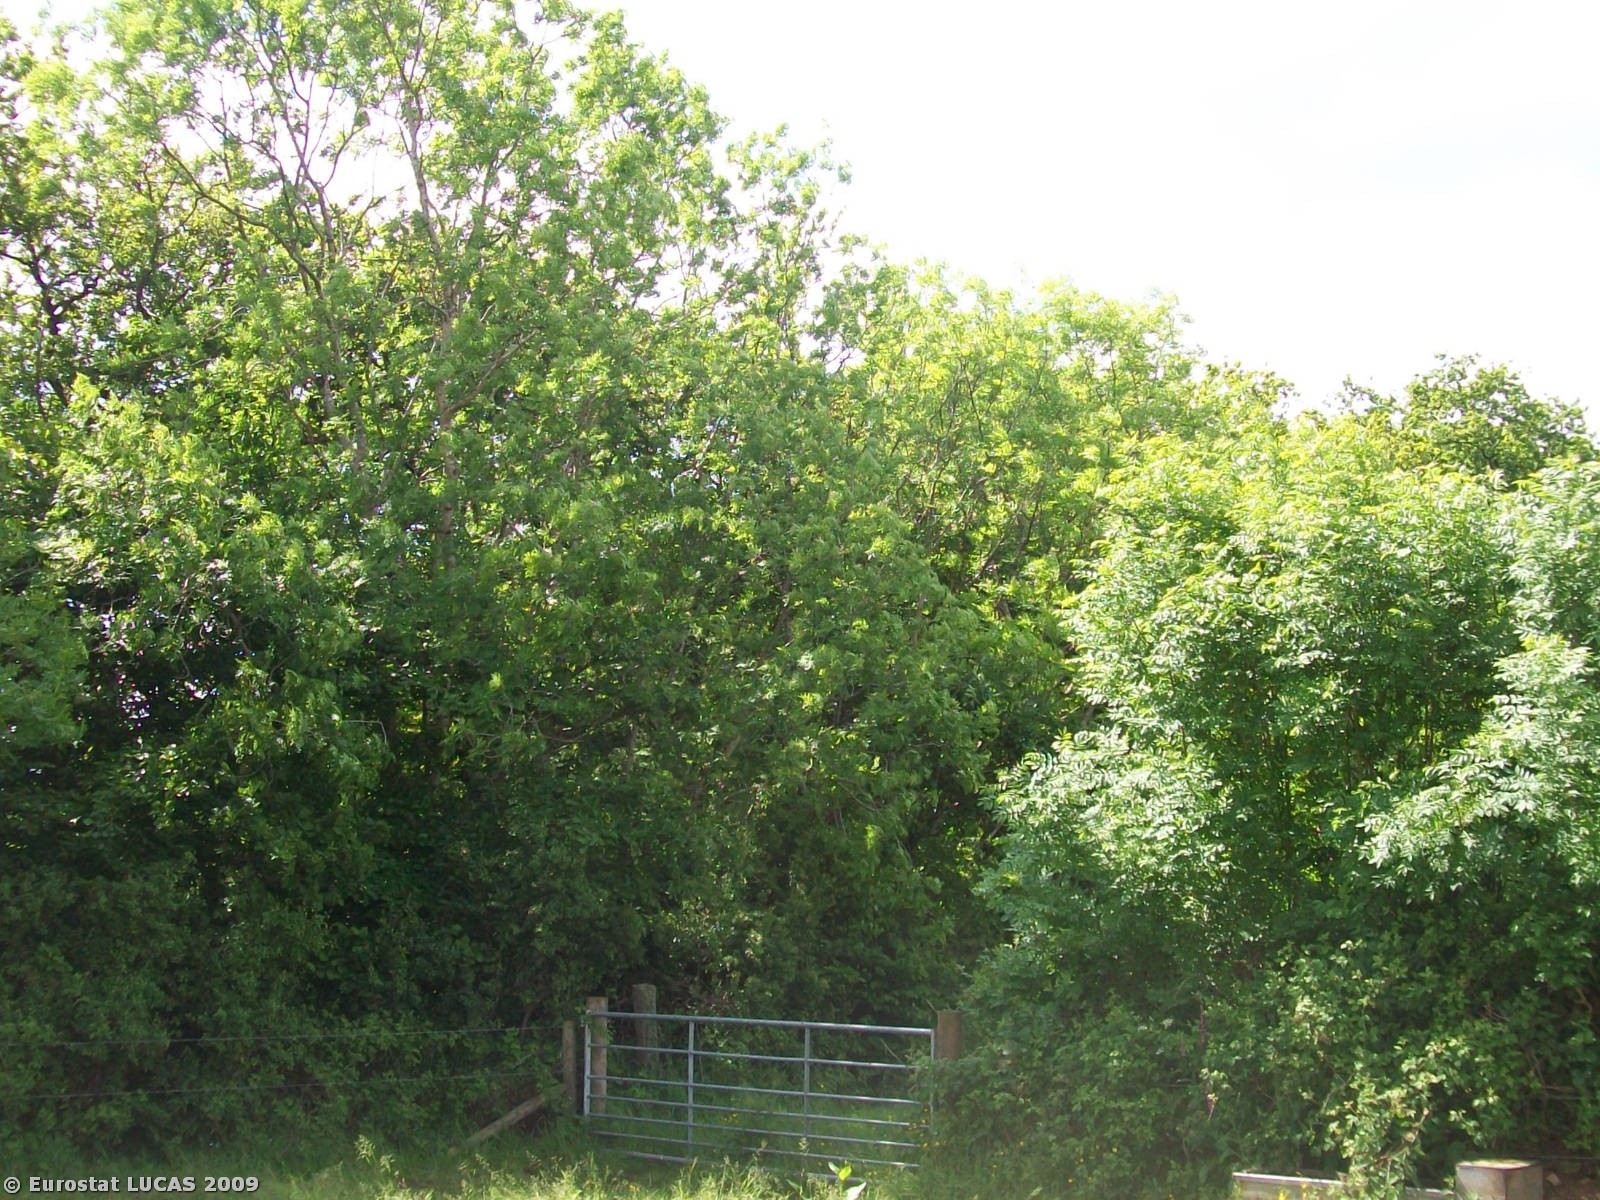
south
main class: Grassland
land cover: Grassland without tree/shrub cover
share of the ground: > 75 %
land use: Agriculture (excluding fallow land and kitchen gardens)
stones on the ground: < 10 %
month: June
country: GB
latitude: 50.9575
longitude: -3.3934
